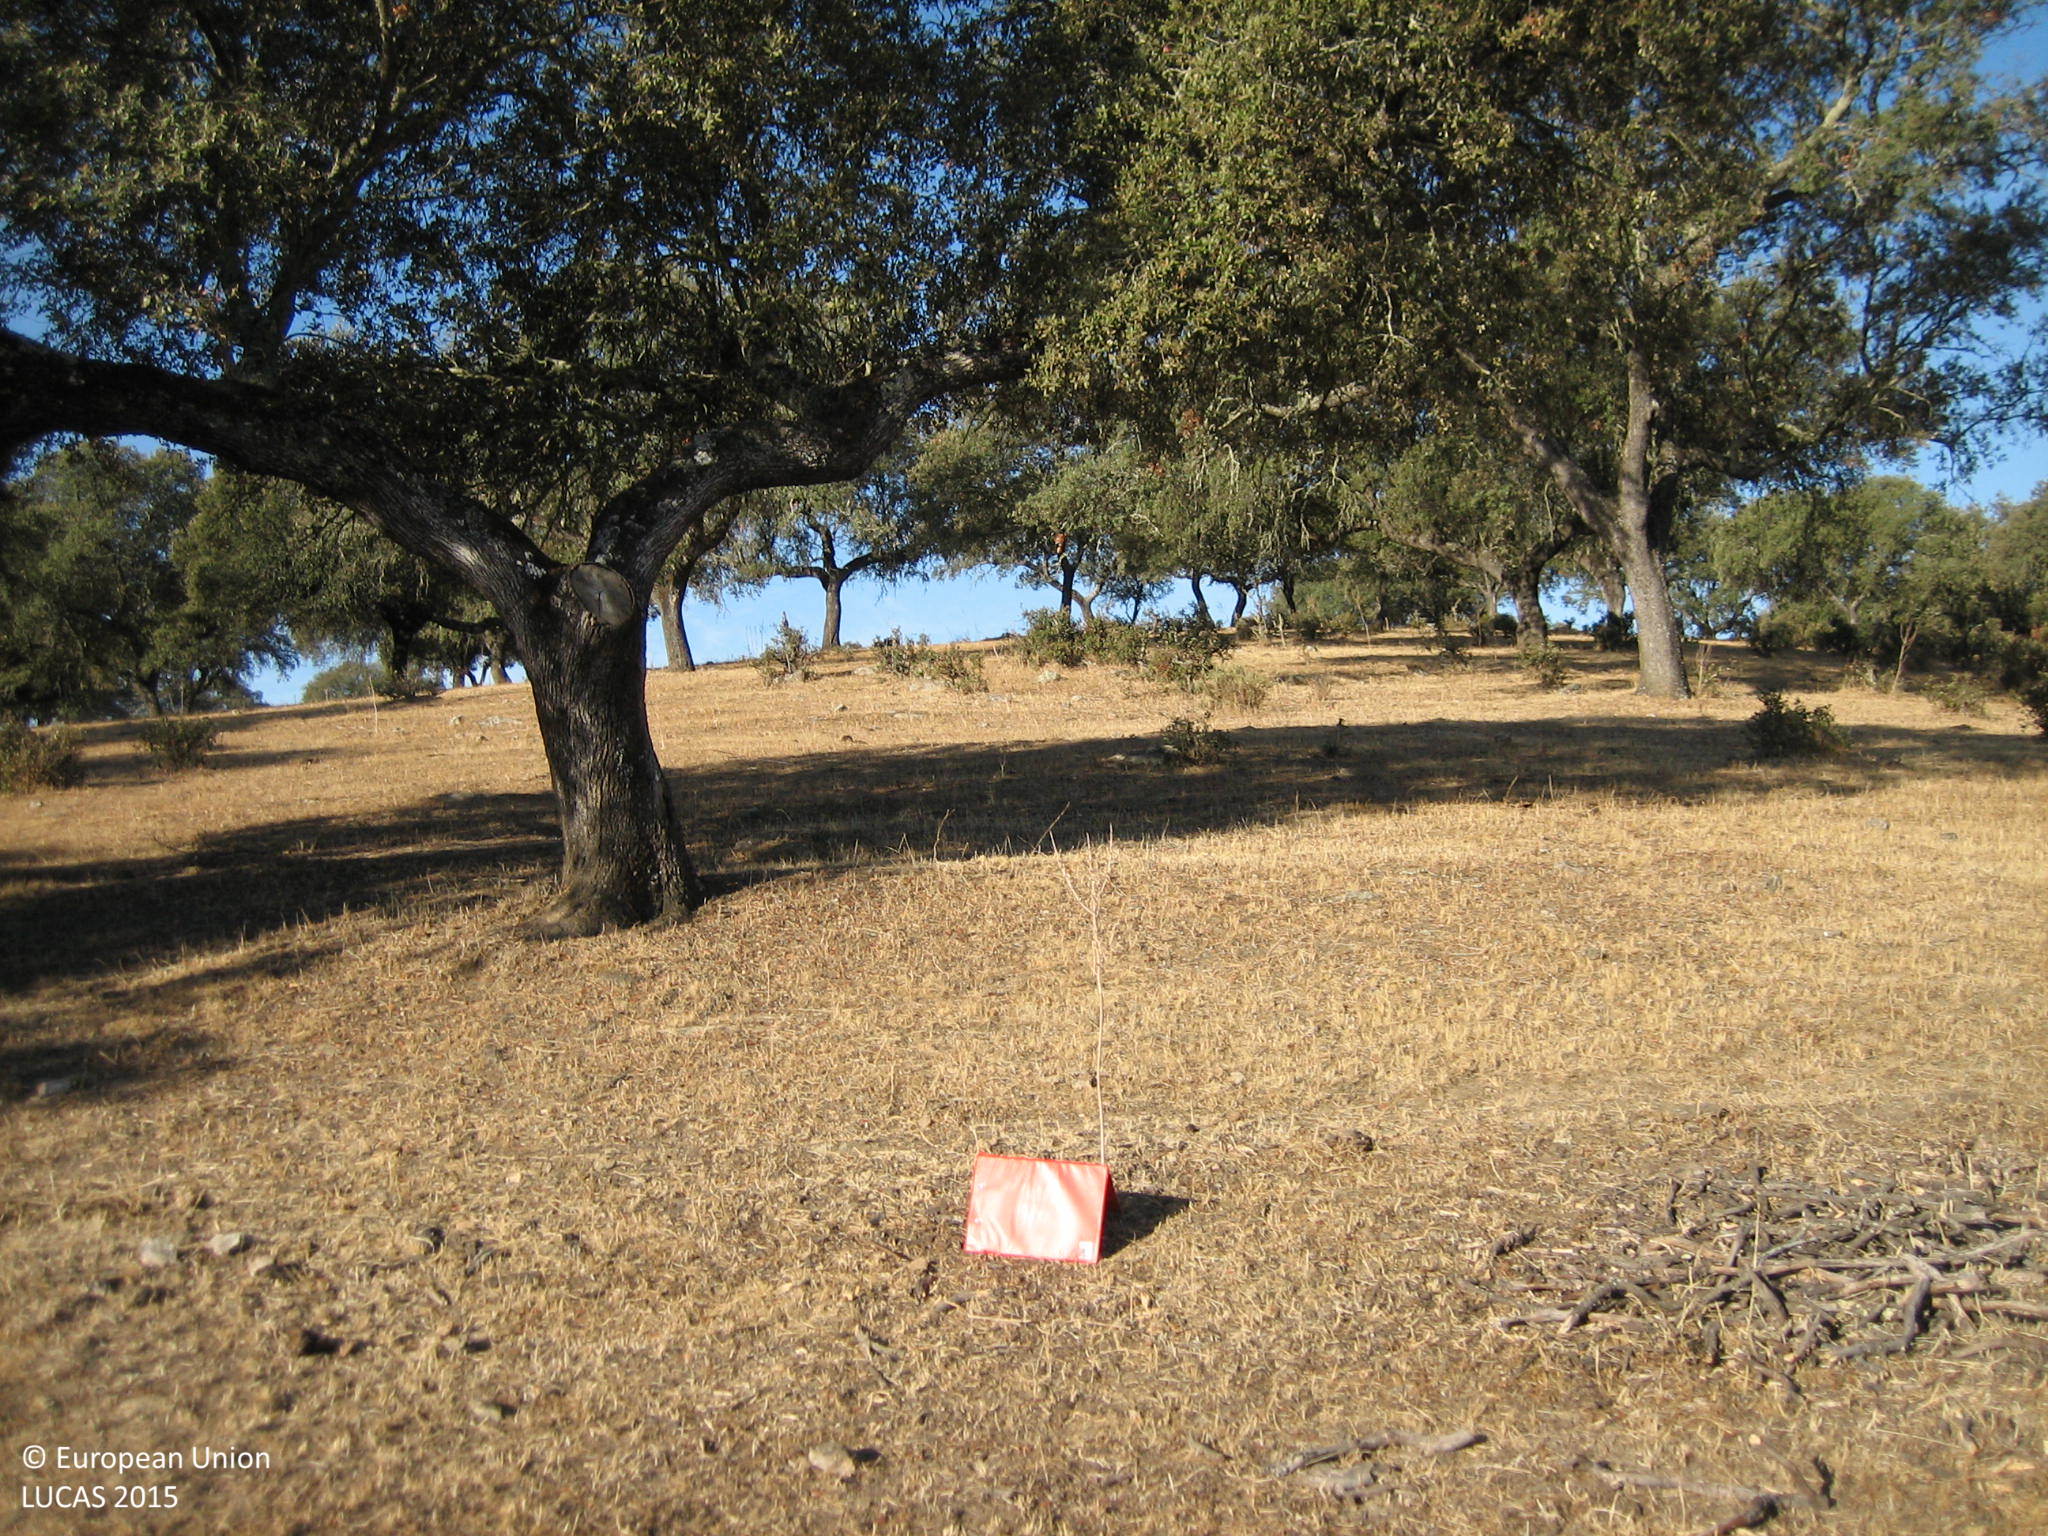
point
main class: Woodland
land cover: Broadleaved woodland
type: broadleaved evergreen forest
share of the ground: 25 - 50 %
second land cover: Grassland without tree/shrub cover
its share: 25 - 50 %
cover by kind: broadleaved forest trees 40 %, herbaceous plants 30 %, unconsolidated bare surface 30 %
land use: Forestry
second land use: Agriculture (excluding fallow land and kitchen gardens)
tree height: > 5 m
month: August
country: ES
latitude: 38.5725
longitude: -7.1823
